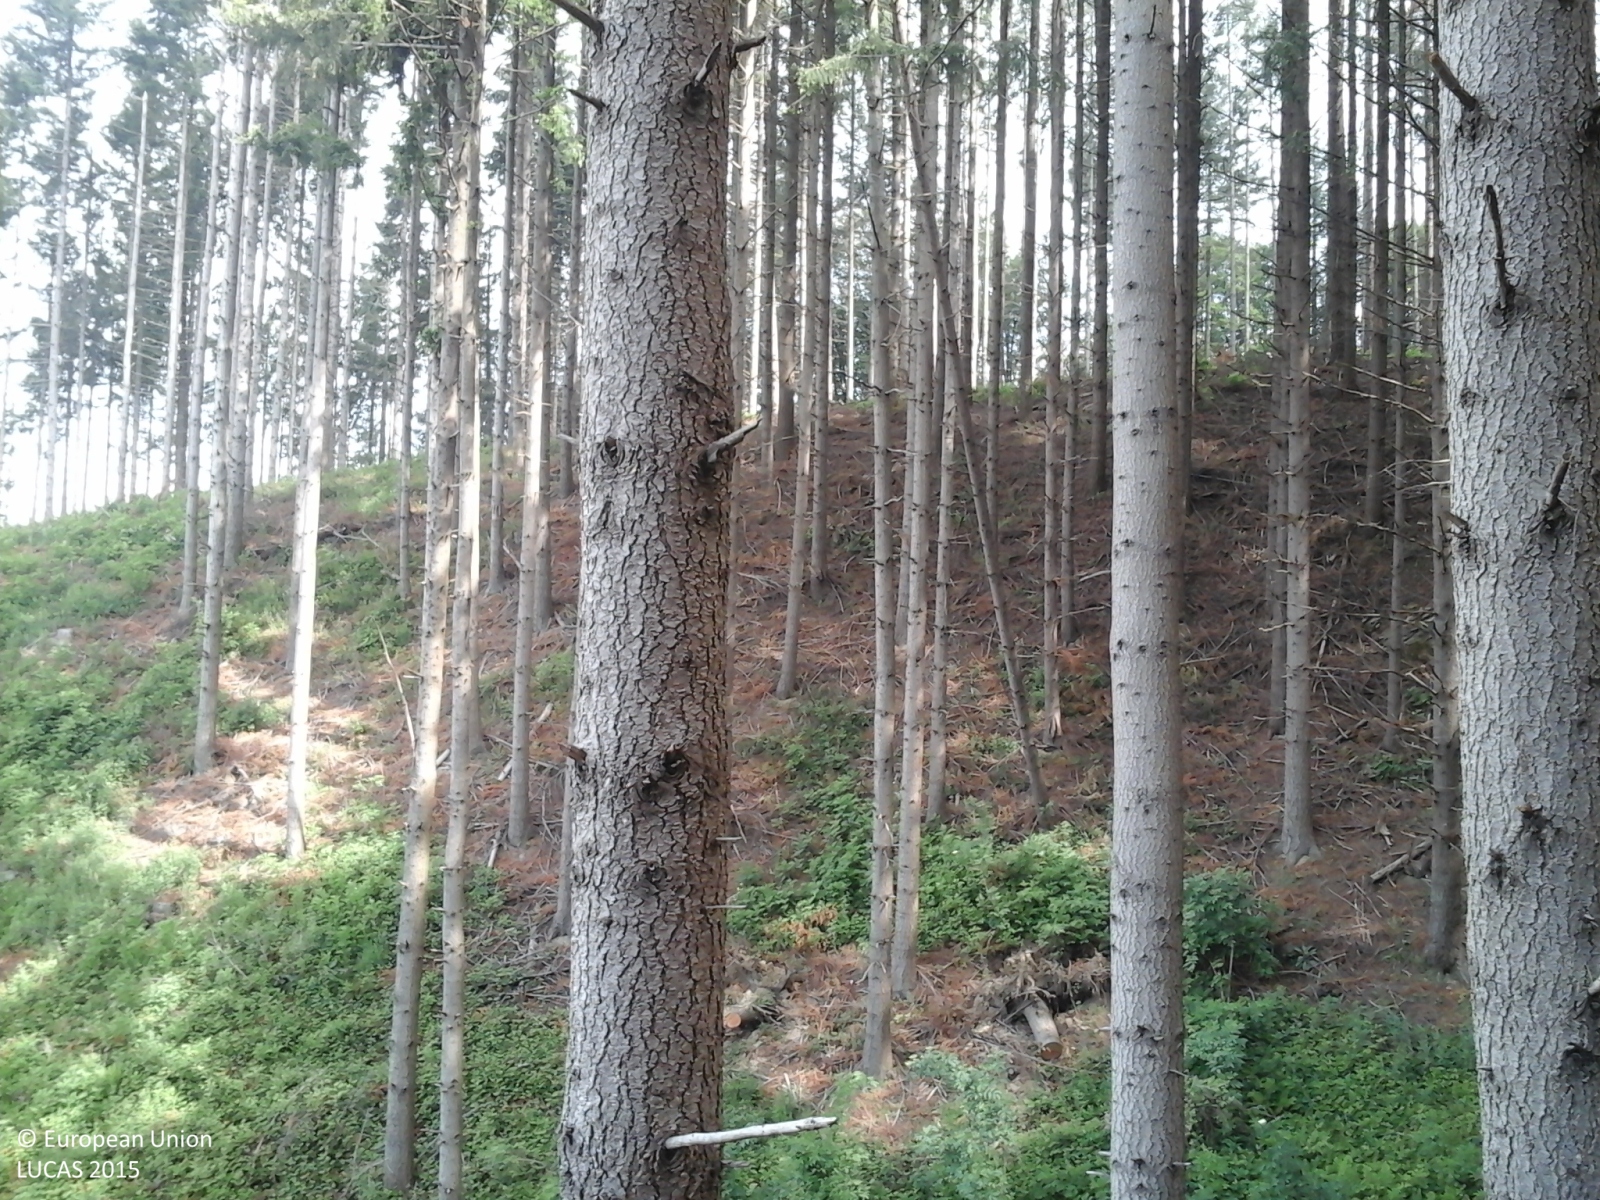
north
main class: Woodland
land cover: Spruce dominated coniferous woodland
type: coniferous forest of the mediterranean region
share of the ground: > 75 %
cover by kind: coniferous forest trees 100 %
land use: Forestry
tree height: > 5 m
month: May
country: IT
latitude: 44.0732
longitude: 11.1833
